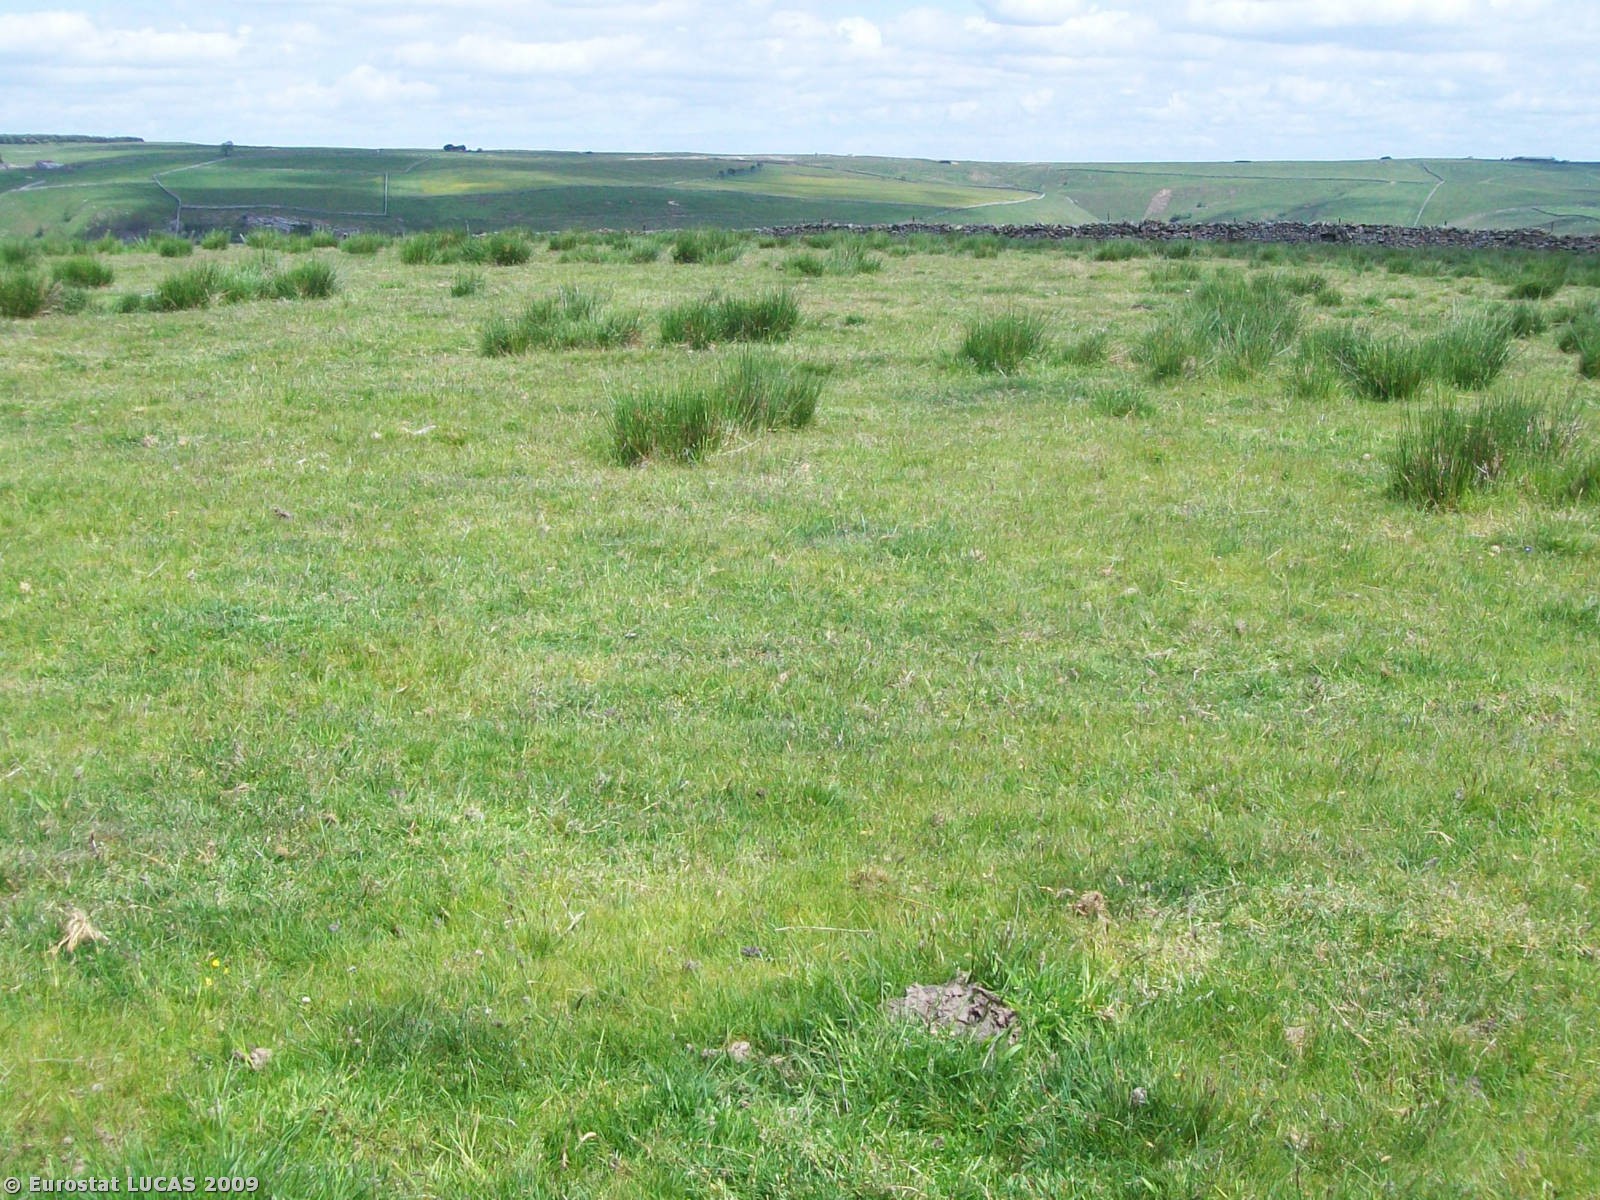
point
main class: Shrubland
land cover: Shrubland without tree cover
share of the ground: > 75 %
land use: Fallow land
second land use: Community services
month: June
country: GB
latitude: 54.4184
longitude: -1.8427
